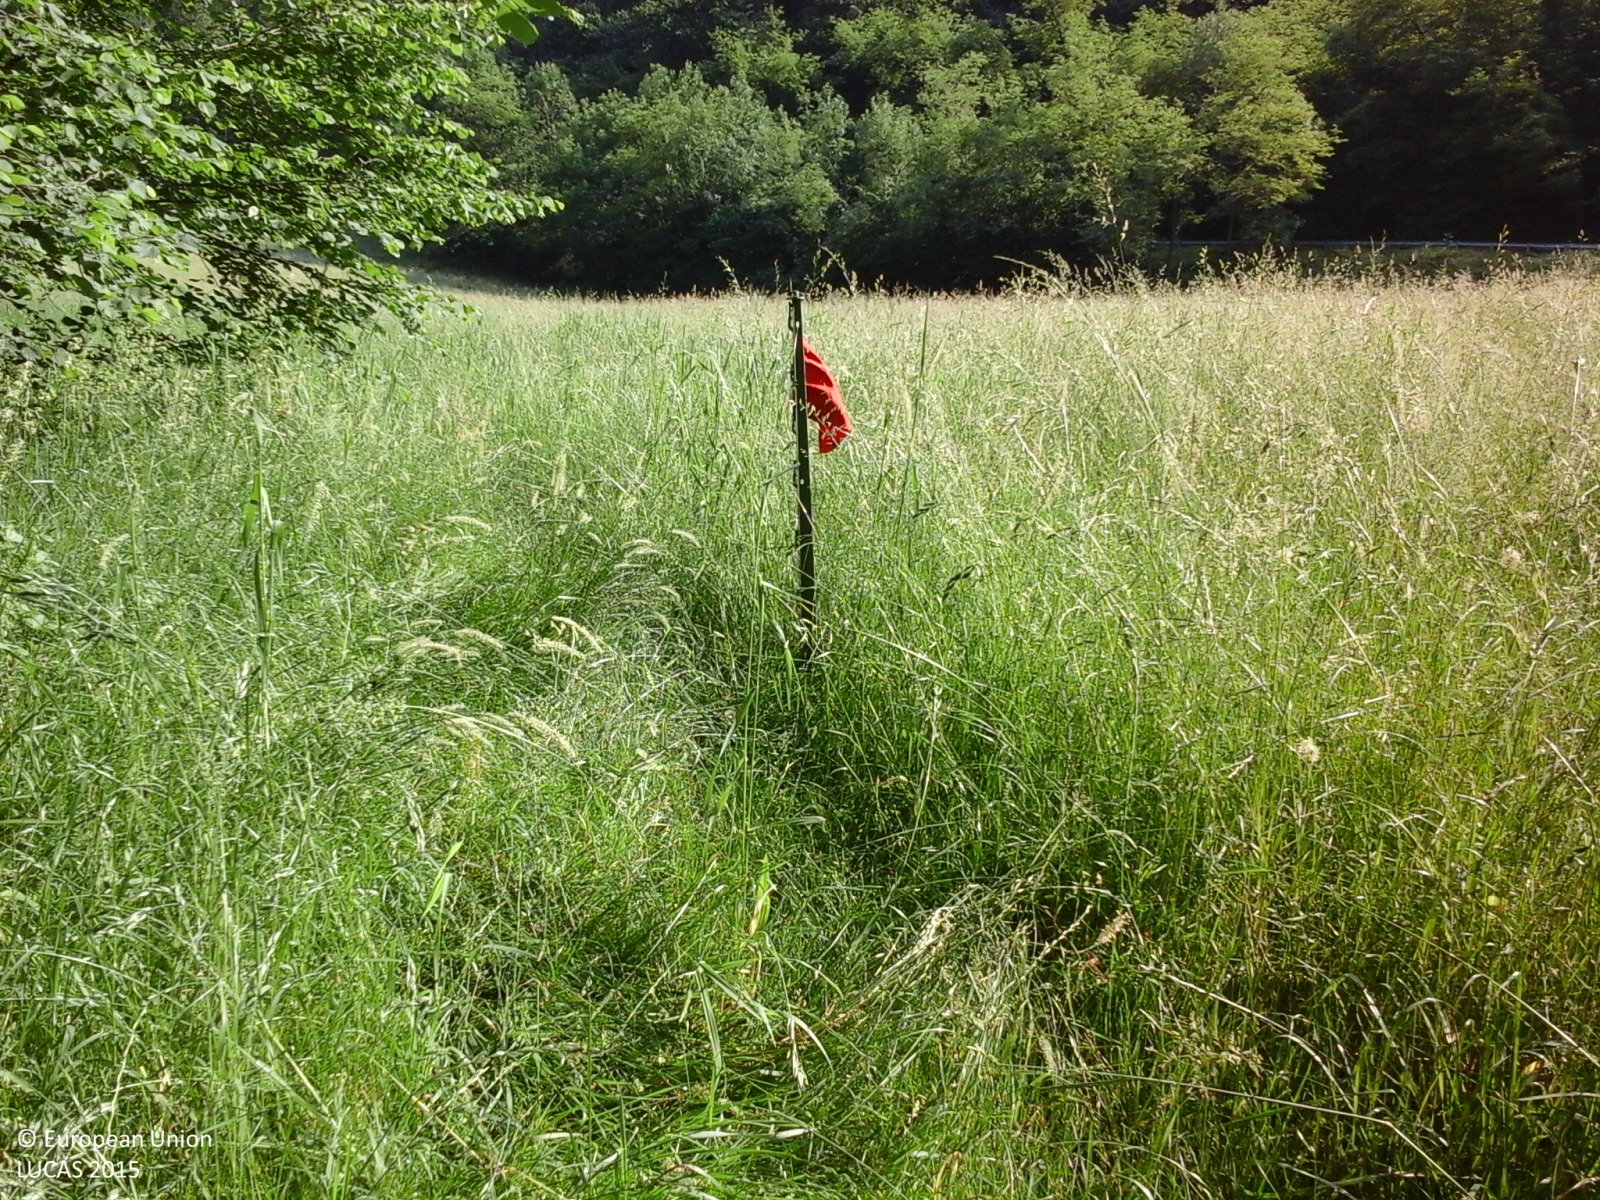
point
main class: Grassland
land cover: Grassland without tree/shrub cover
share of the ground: > 75 %
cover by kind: herbaceous plants 100 %
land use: Agriculture (excluding fallow land and kitchen gardens)
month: June
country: IT
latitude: 45.8162
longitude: 8.3680
